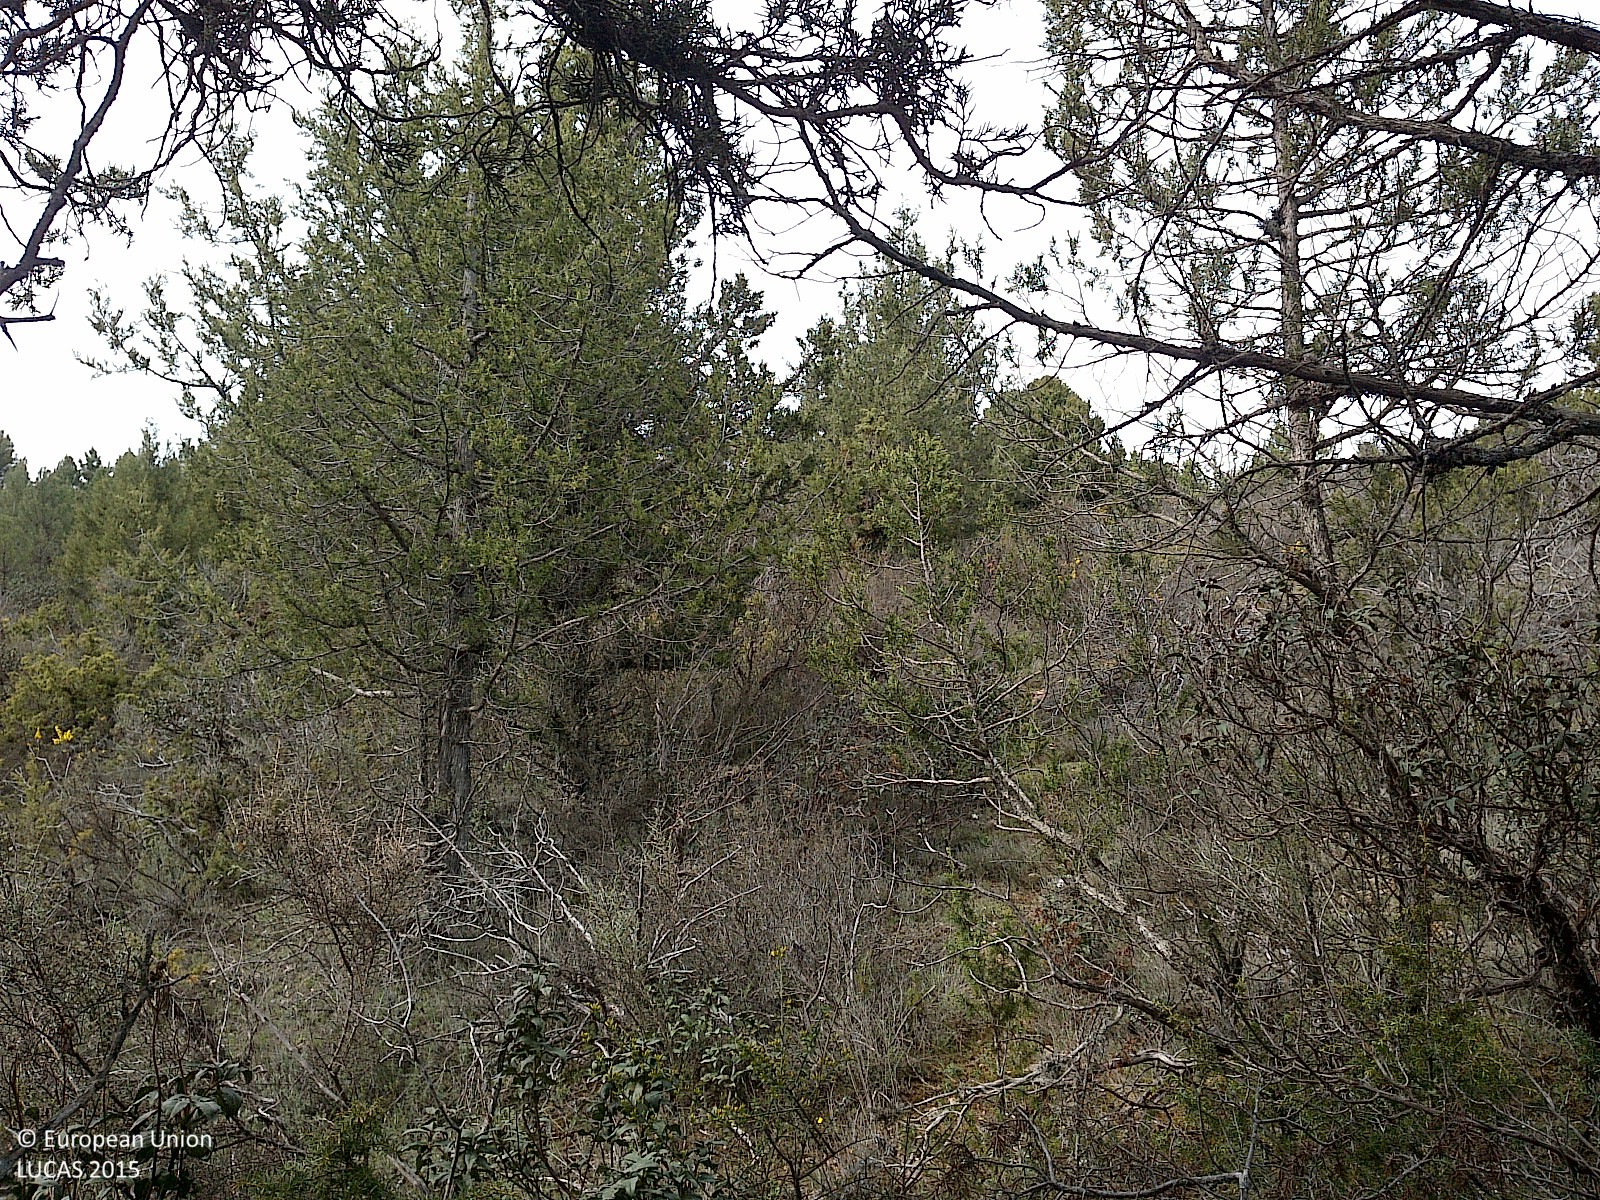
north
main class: Woodland
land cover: Other coniferous woodland
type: coniferous forest of the mediterranean region
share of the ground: 25 - 50 %
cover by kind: shrubs 65 %, coniferous forest trees 30 %, herbaceous plants 5 %
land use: Semi-natural and natural areas not in use
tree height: > 5 m
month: April
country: ES
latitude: 41.6982
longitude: -3.0336
